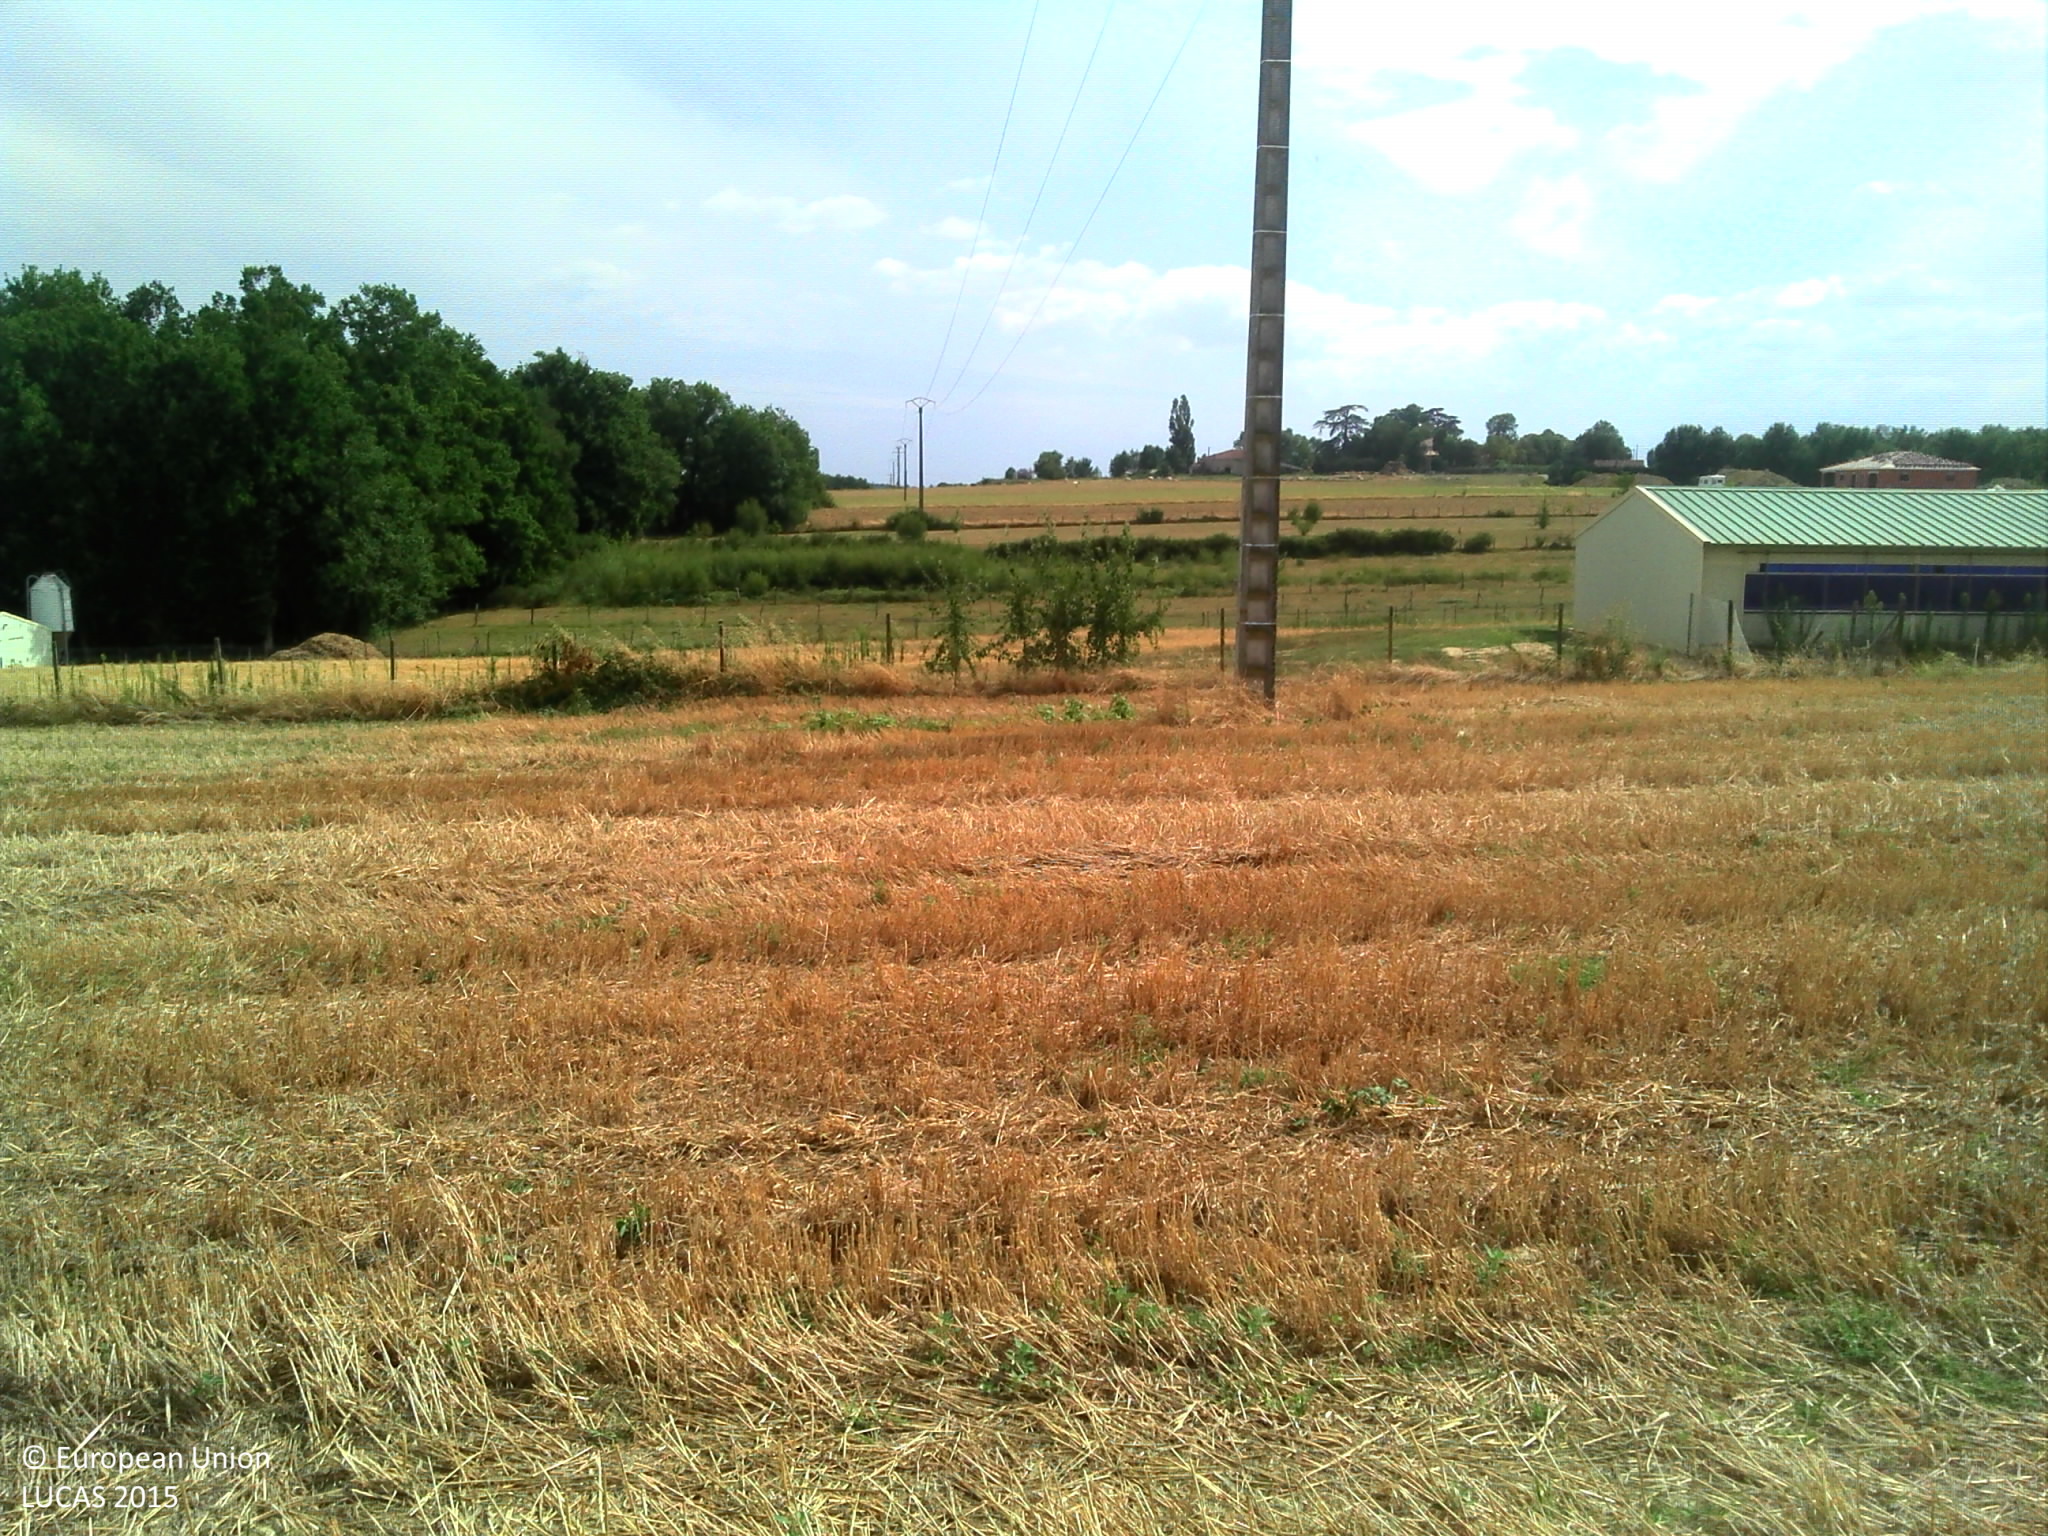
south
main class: Cropland
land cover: Common wheat
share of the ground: > 75 %
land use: Agriculture (excluding fallow land and kitchen gardens)
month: July
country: FR
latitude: 44.1124
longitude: 0.6872
